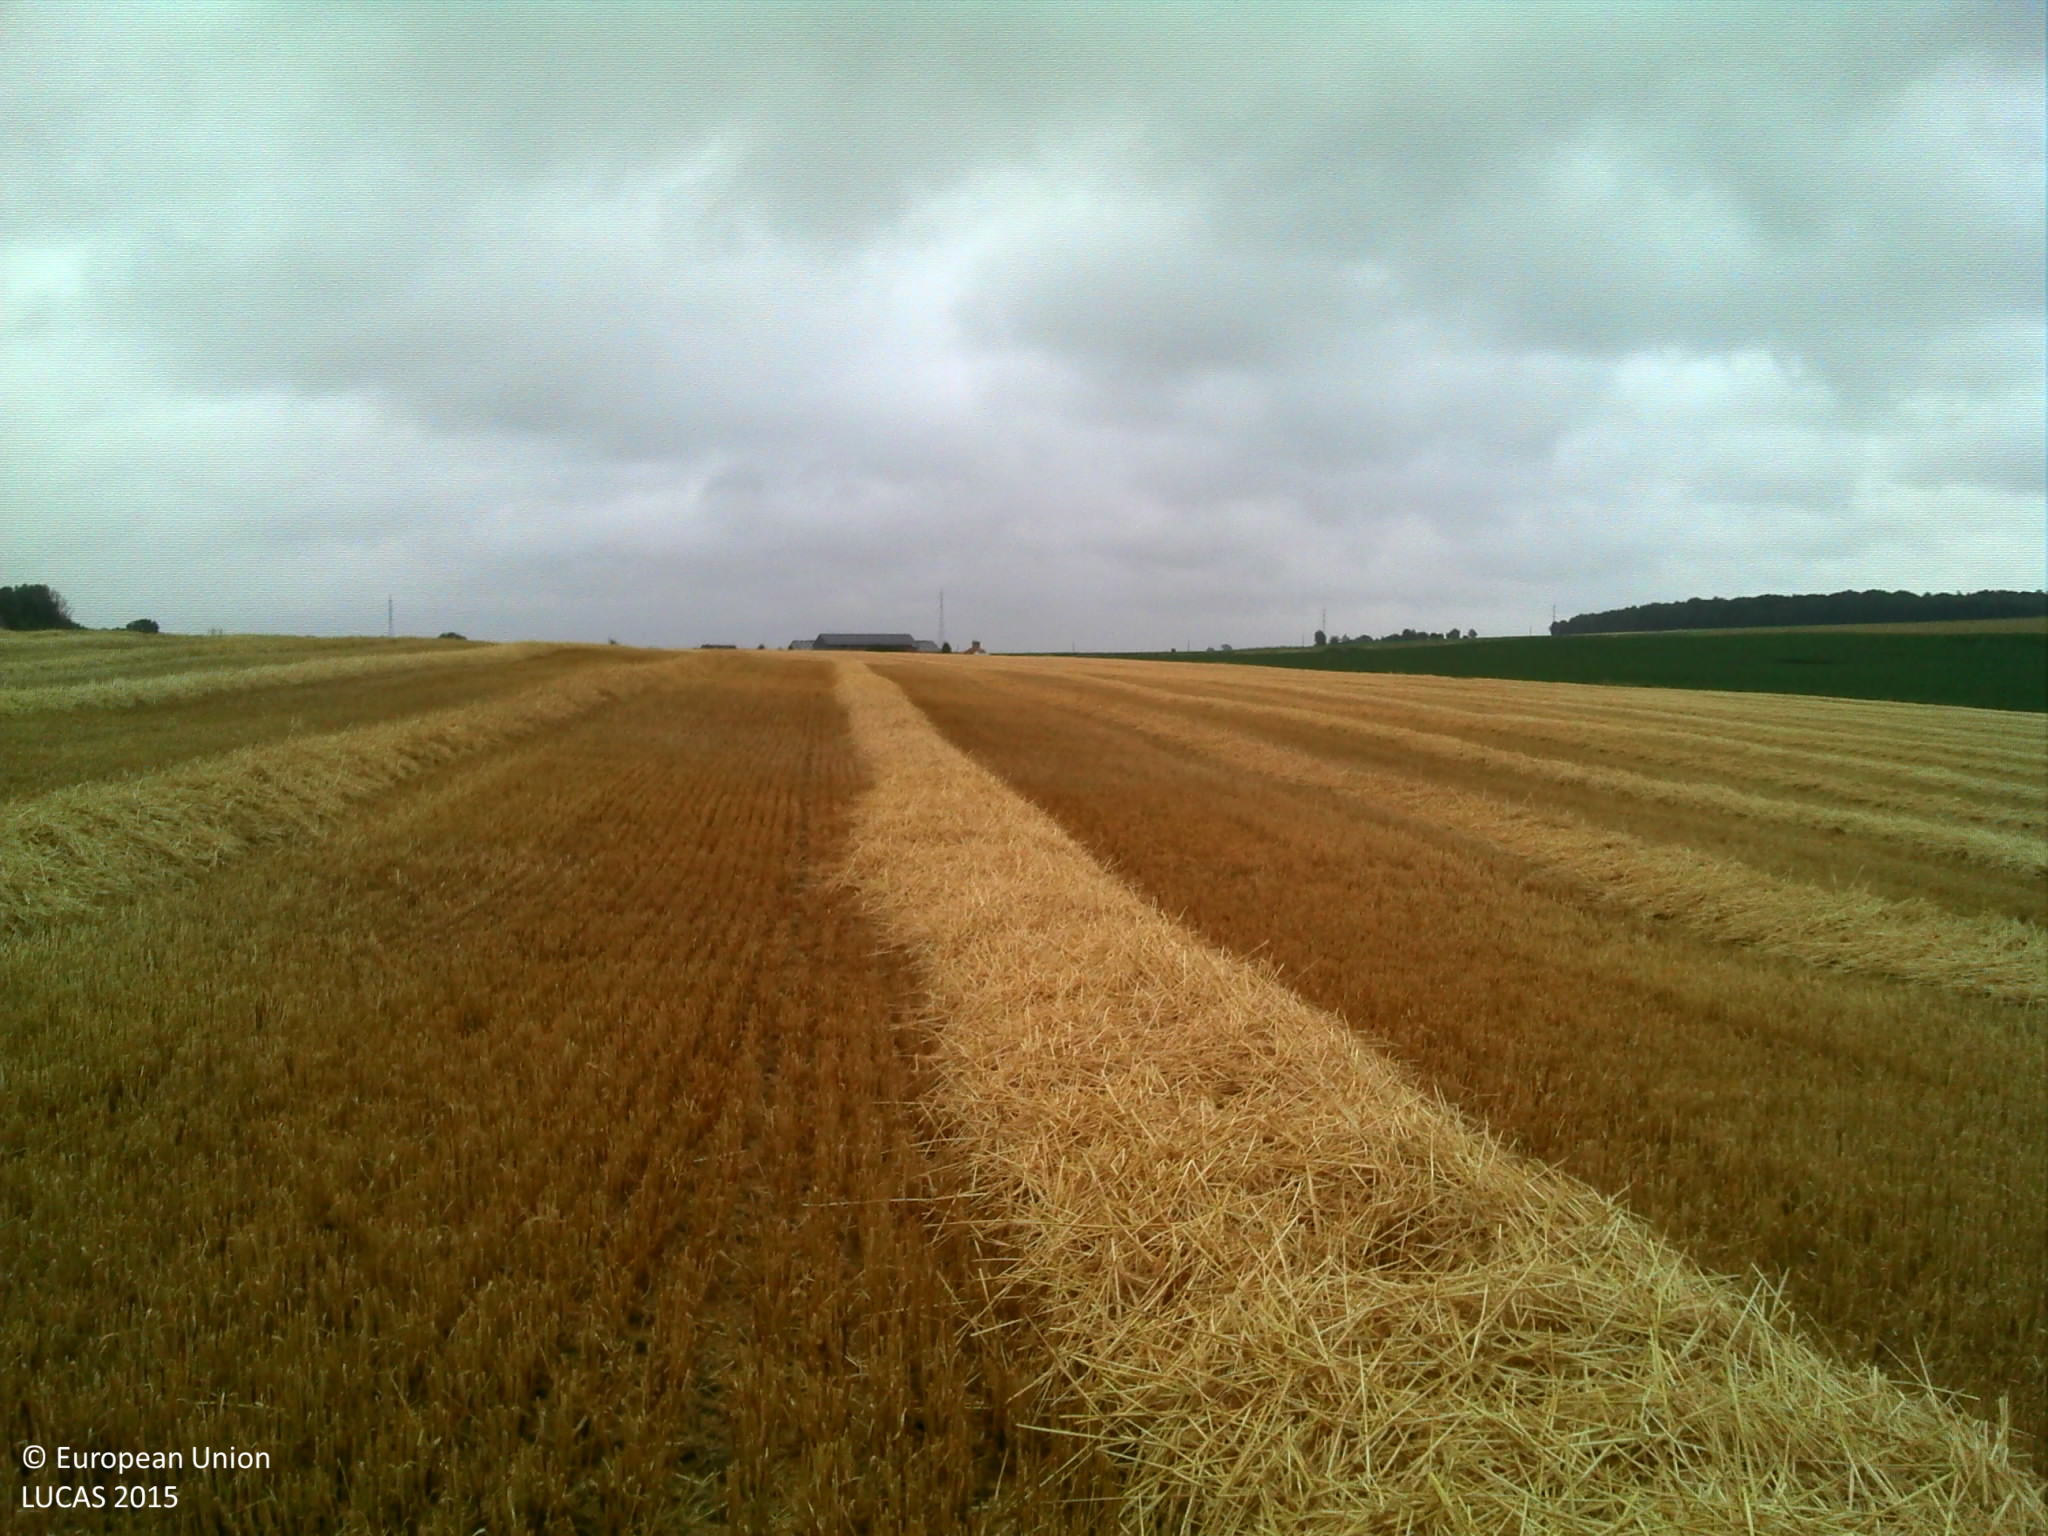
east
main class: Cropland
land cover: Barley
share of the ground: < 10 %
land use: Agriculture (excluding fallow land and kitchen gardens)
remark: Harvested field
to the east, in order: Barley
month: July
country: BE
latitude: 50.2436
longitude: 4.3726
